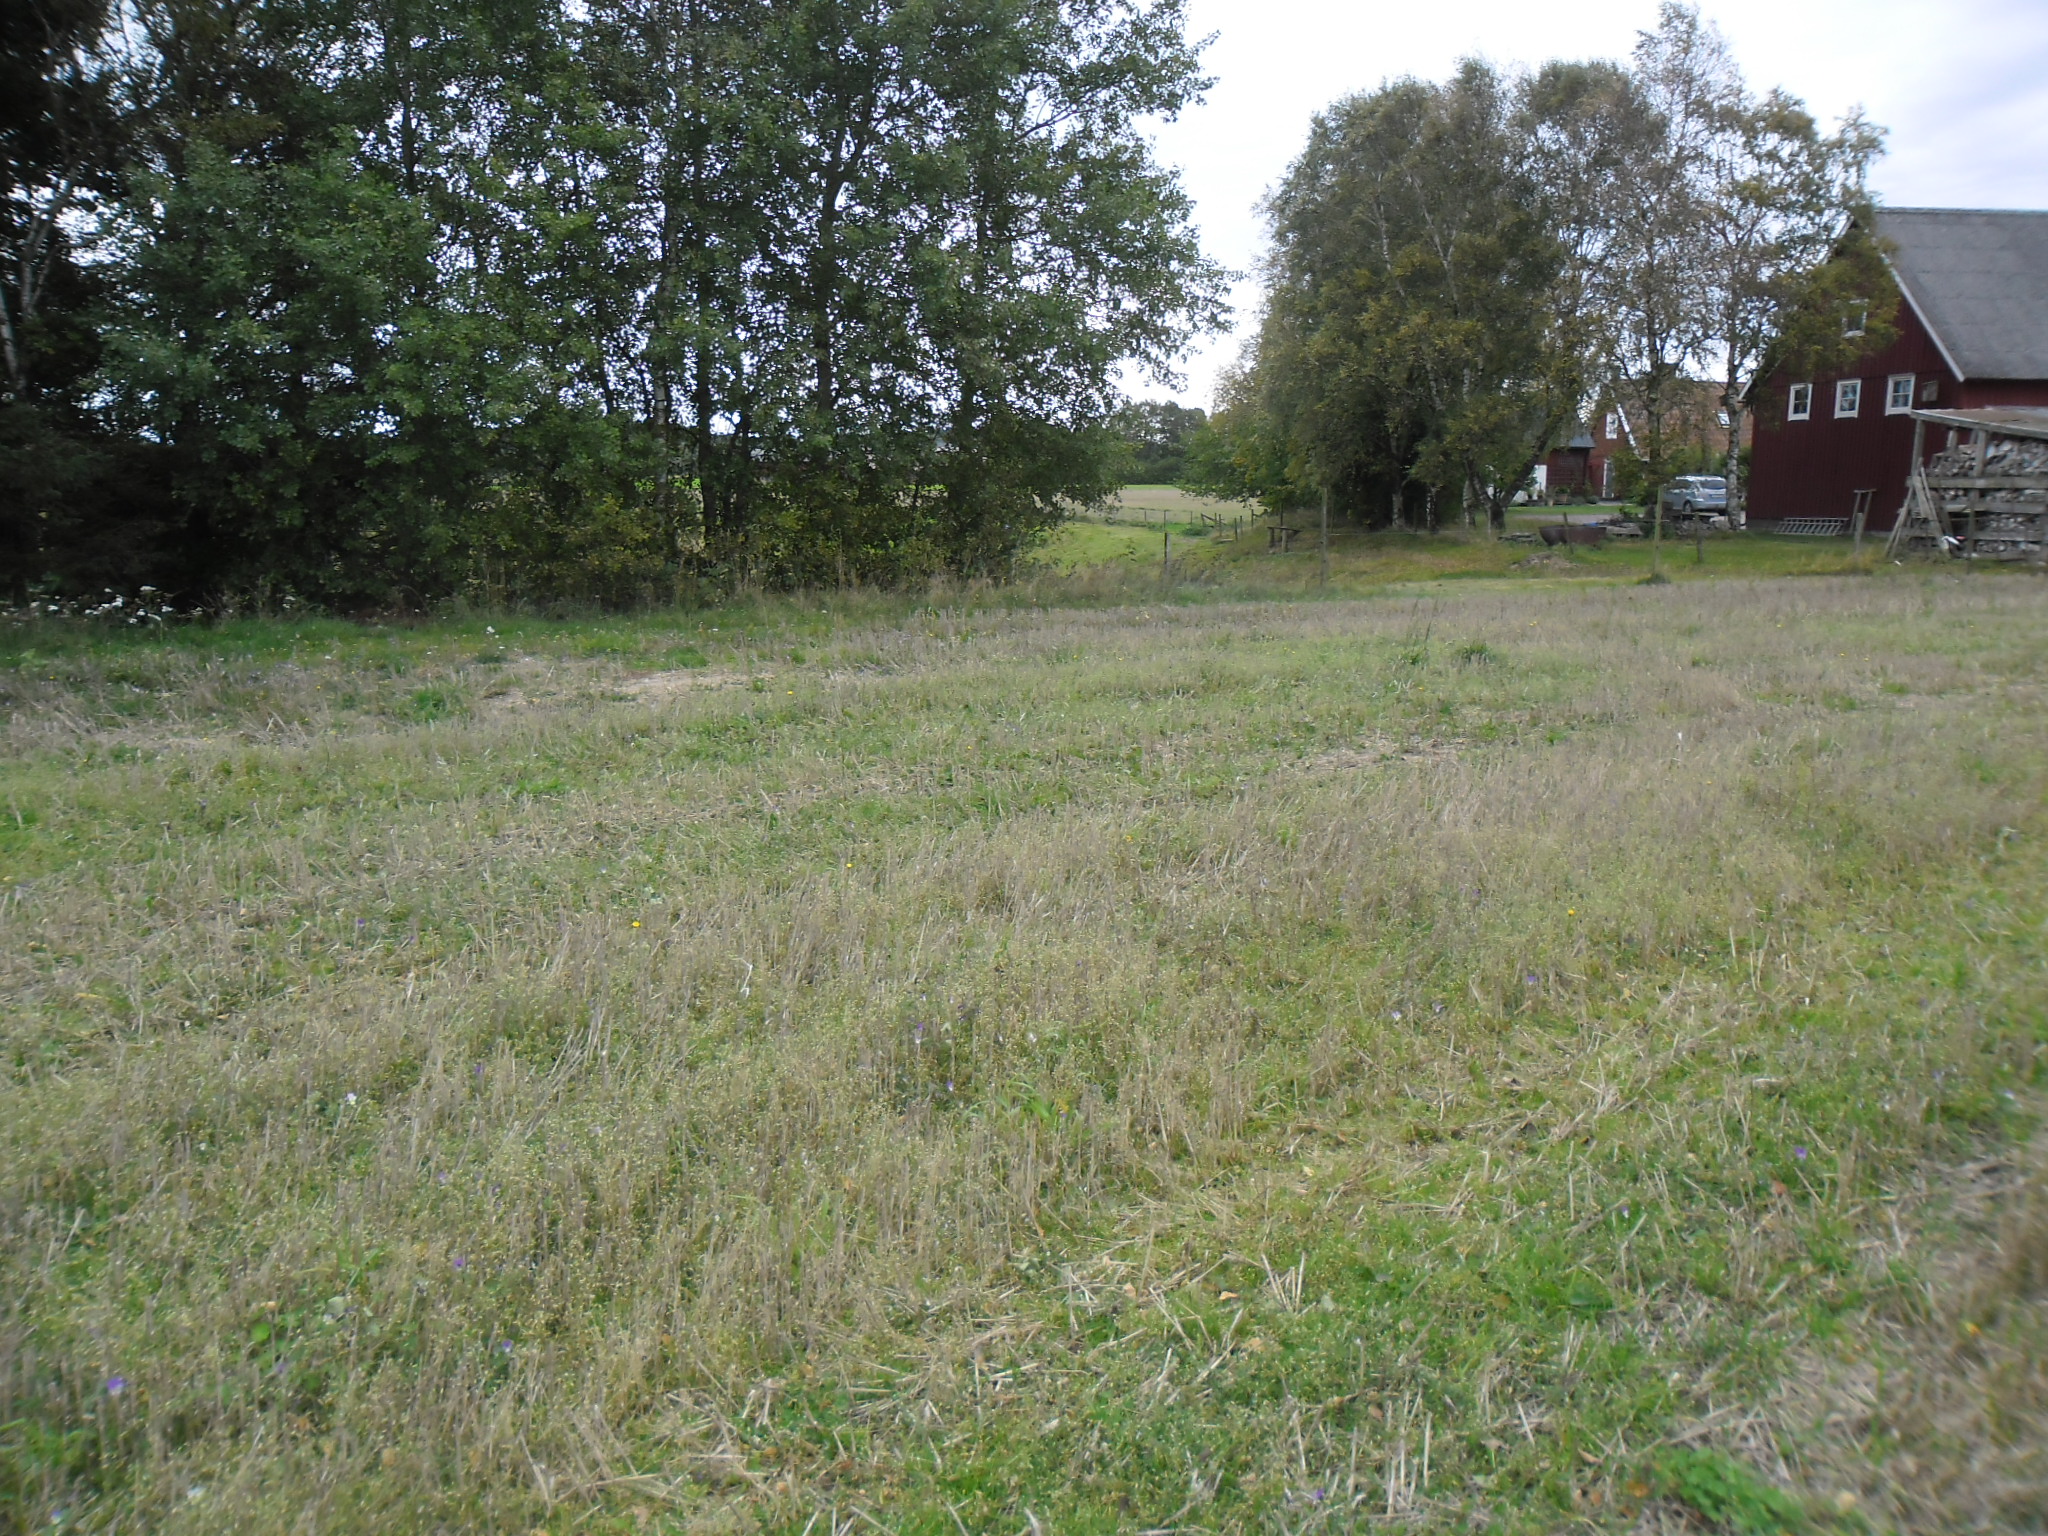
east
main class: Cropland
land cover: Common wheat
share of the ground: < 10 %
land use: Agriculture (excluding fallow land and kitchen gardens)
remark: Harvested field
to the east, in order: Common wheat; Broadleaved woodland; Fences; Grassland without tree/shrub cover; Fences; Barley; Grassland without tree/shrub cover
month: October
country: SE
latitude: 56.5812
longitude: 13.1390
